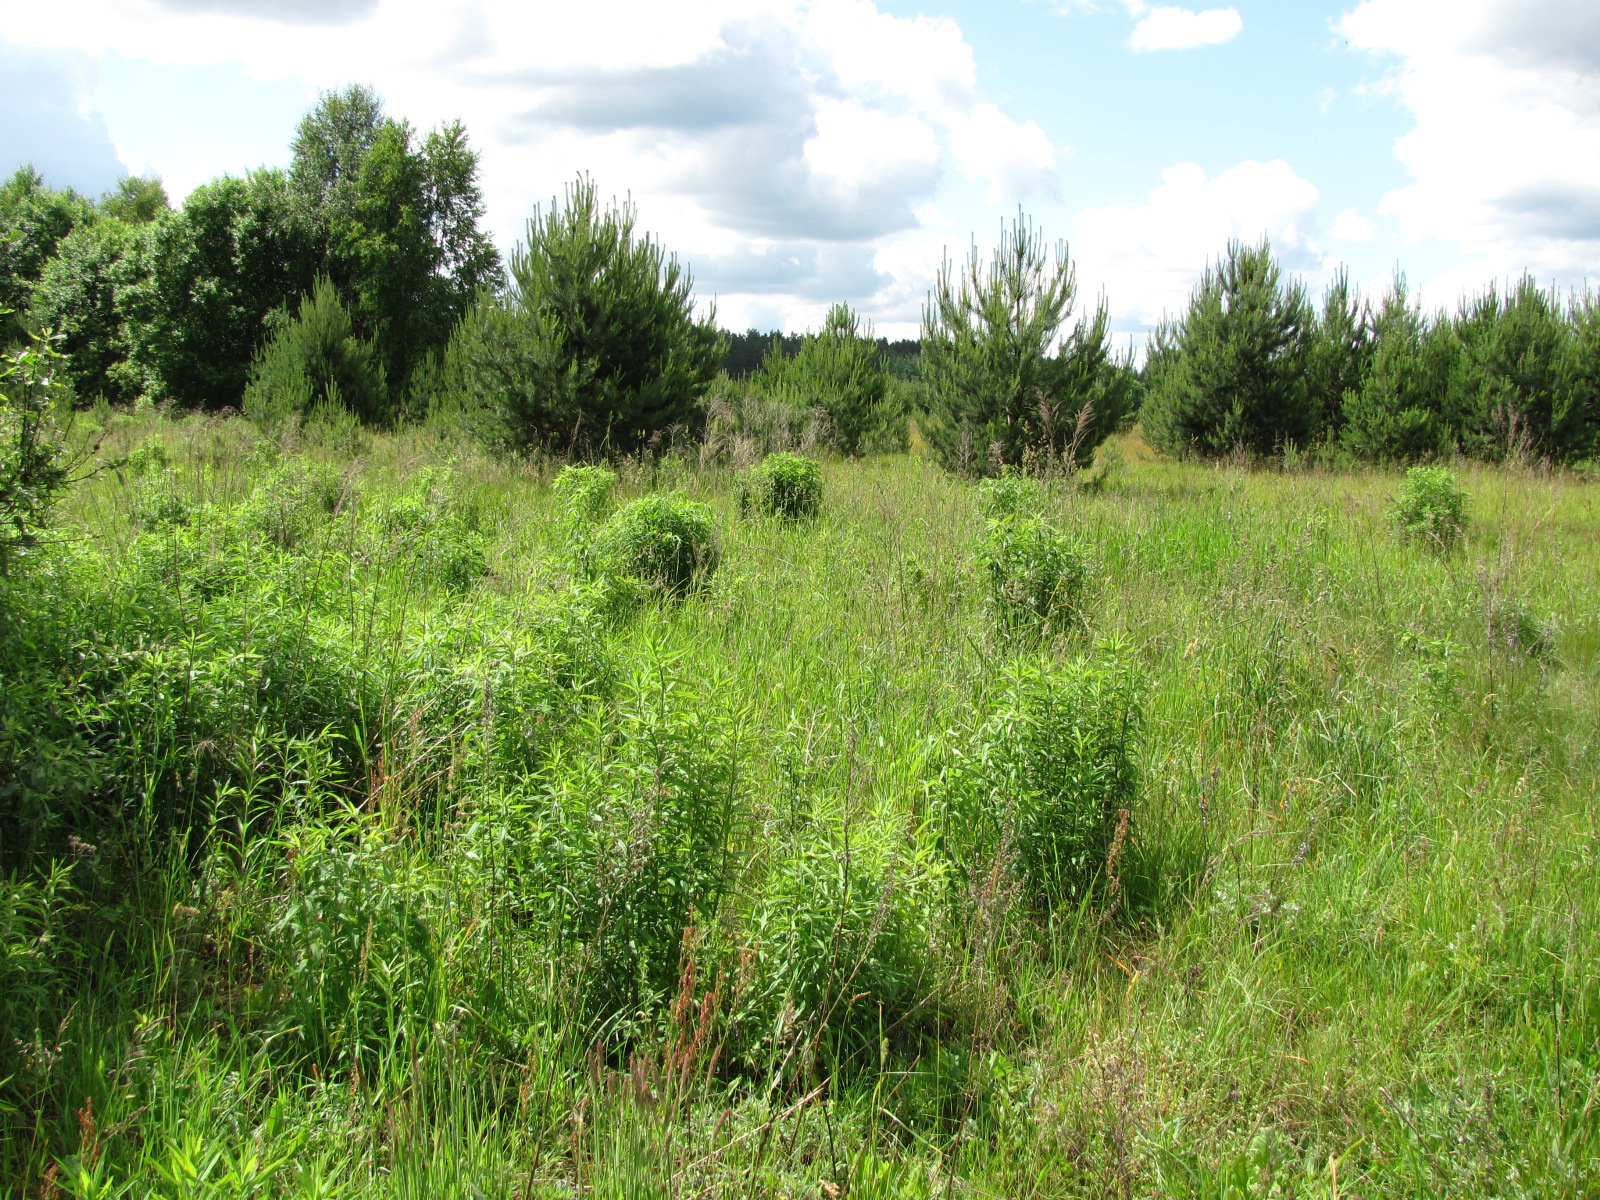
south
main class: Grassland
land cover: Grassland with sparse tree/shrub cover
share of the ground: > 75 %
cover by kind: herbaceous plants 95 %, coniferous forest trees 5 %
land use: Semi-natural and natural areas not in use
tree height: < 5 m
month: June
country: LV
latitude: 56.9712
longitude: 23.9828
